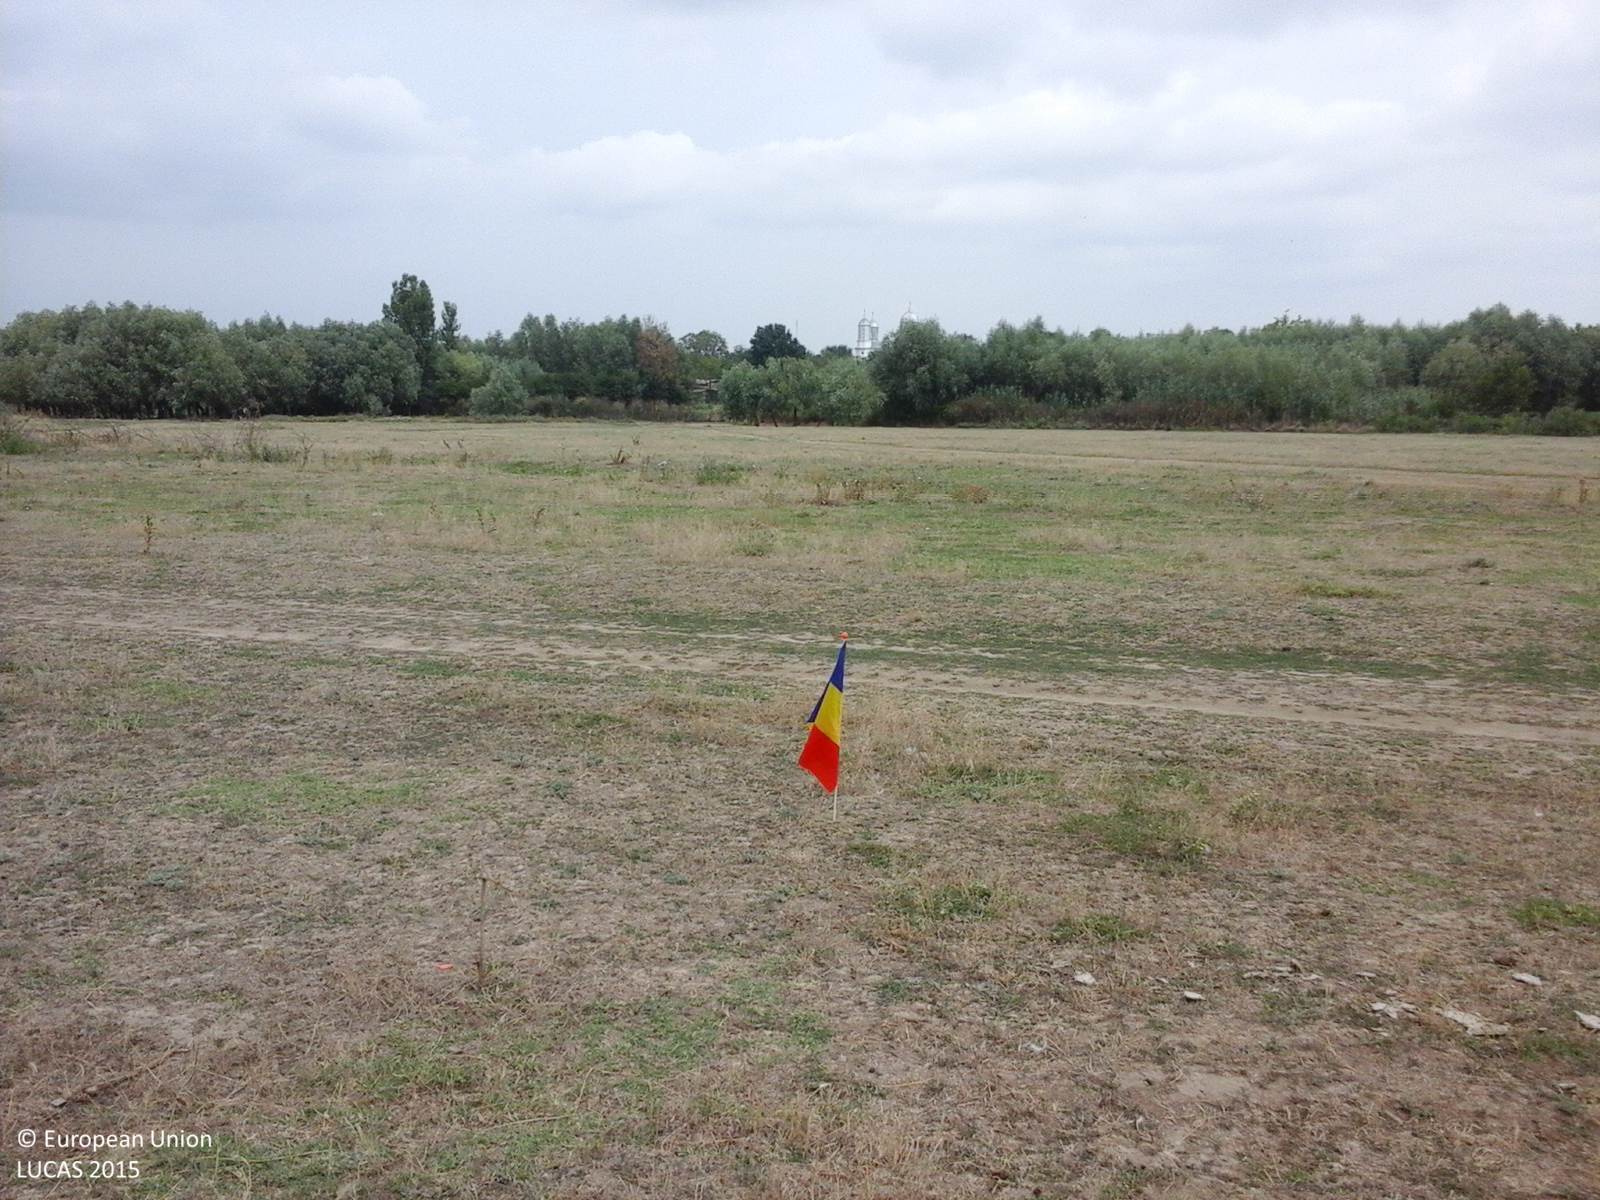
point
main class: Grassland
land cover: Spontaneously vegetated surfaces
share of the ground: > 75 %
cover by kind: herbaceous plants 100 %
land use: Semi-natural and natural areas not in use
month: July
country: RO
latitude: 45.0253
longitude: 28.2311
